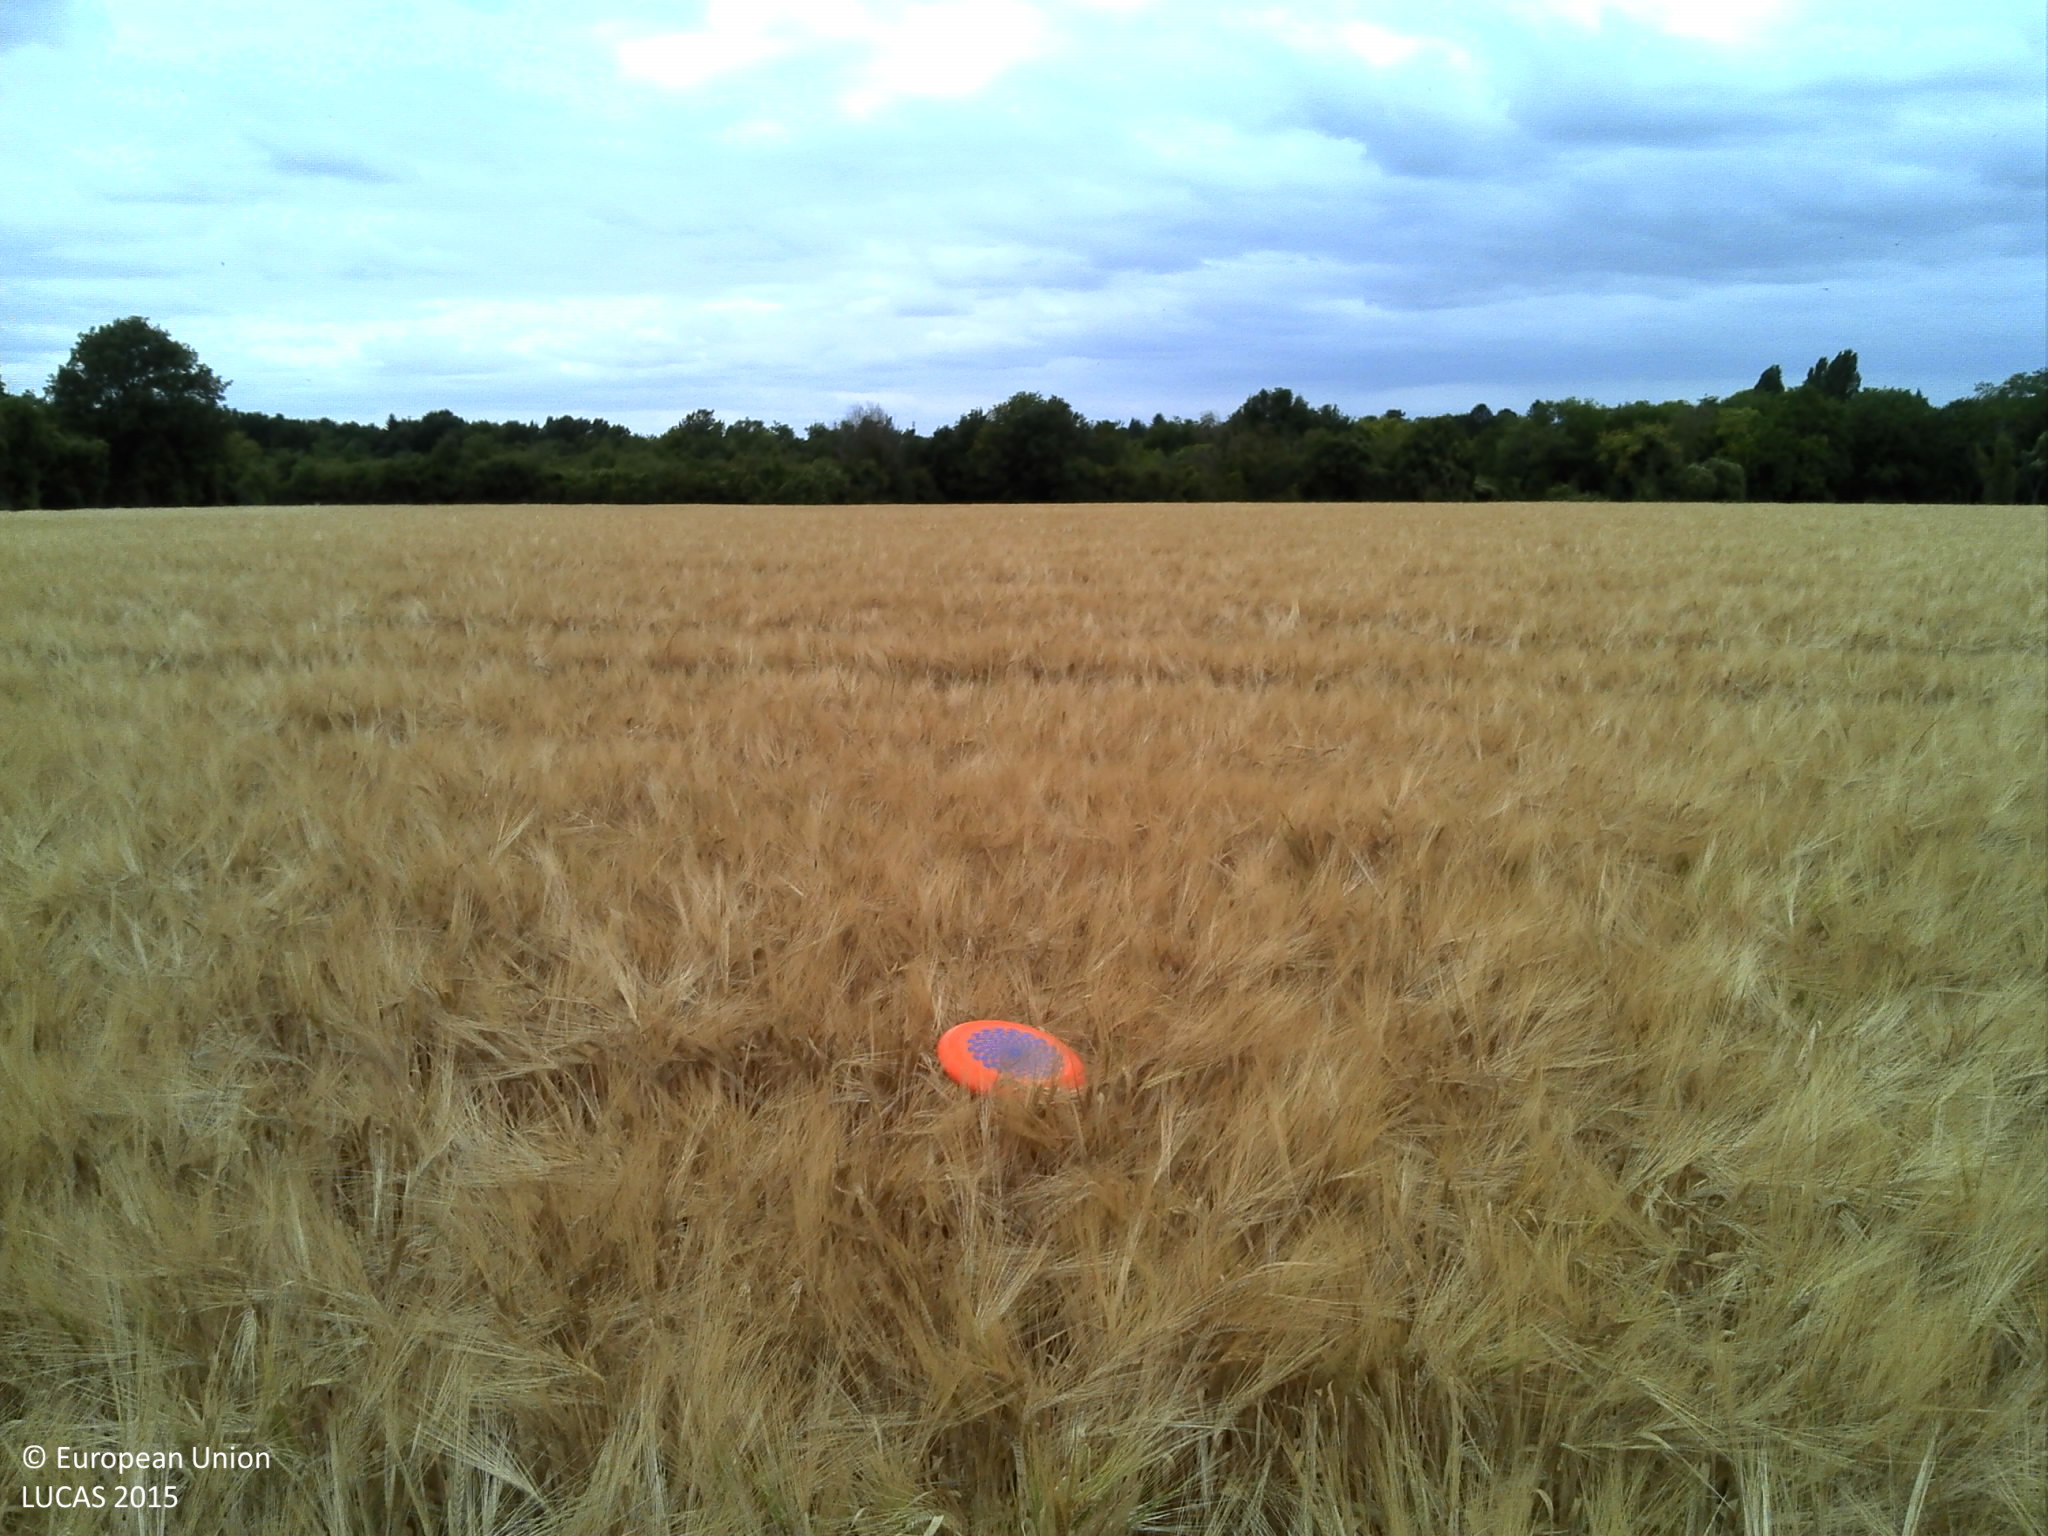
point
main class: Cropland
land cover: Barley
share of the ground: > 75 %
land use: Agriculture (excluding fallow land and kitchen gardens)
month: July
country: FR
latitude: 48.4868
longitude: 2.4256
